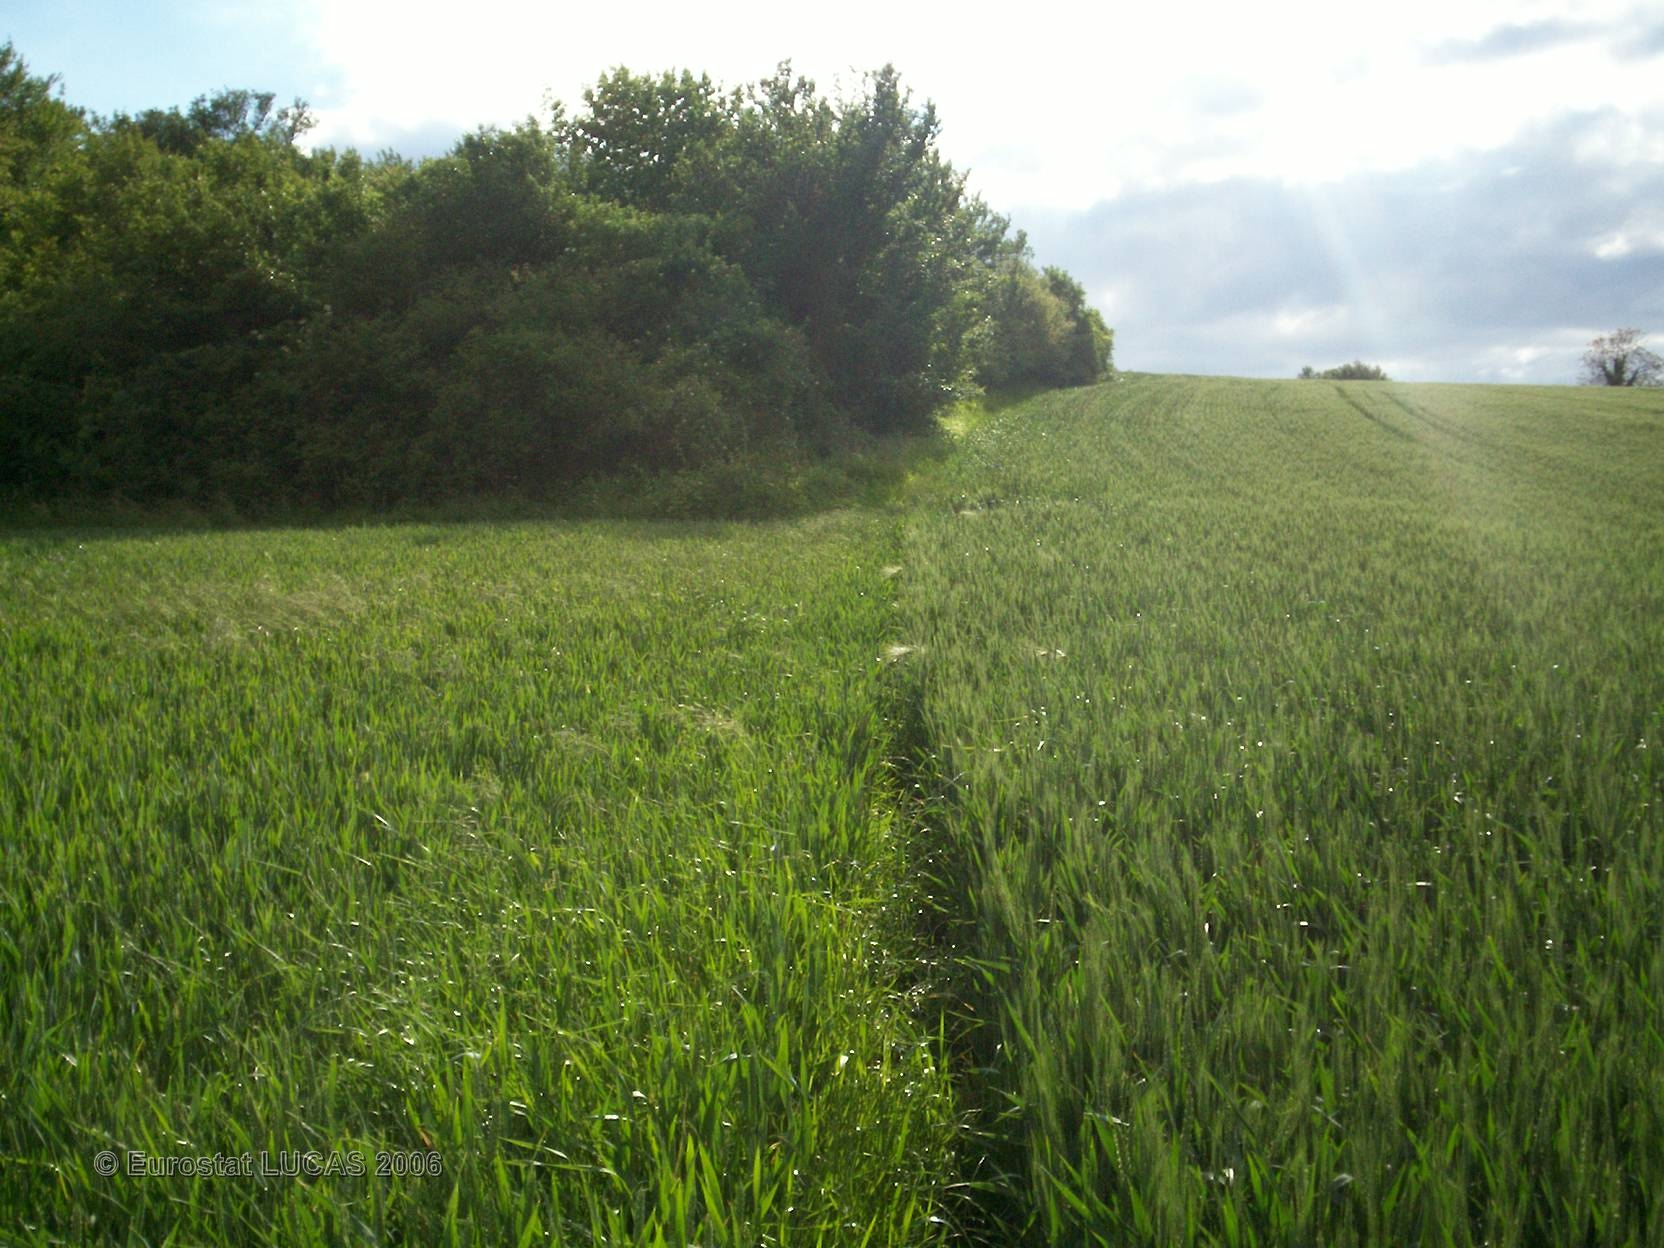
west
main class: Cropland
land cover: Common wheat
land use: Agriculture (excluding fallow land and kitchen gardens)
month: May
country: FR
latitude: 48.9074
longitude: 2.7727
